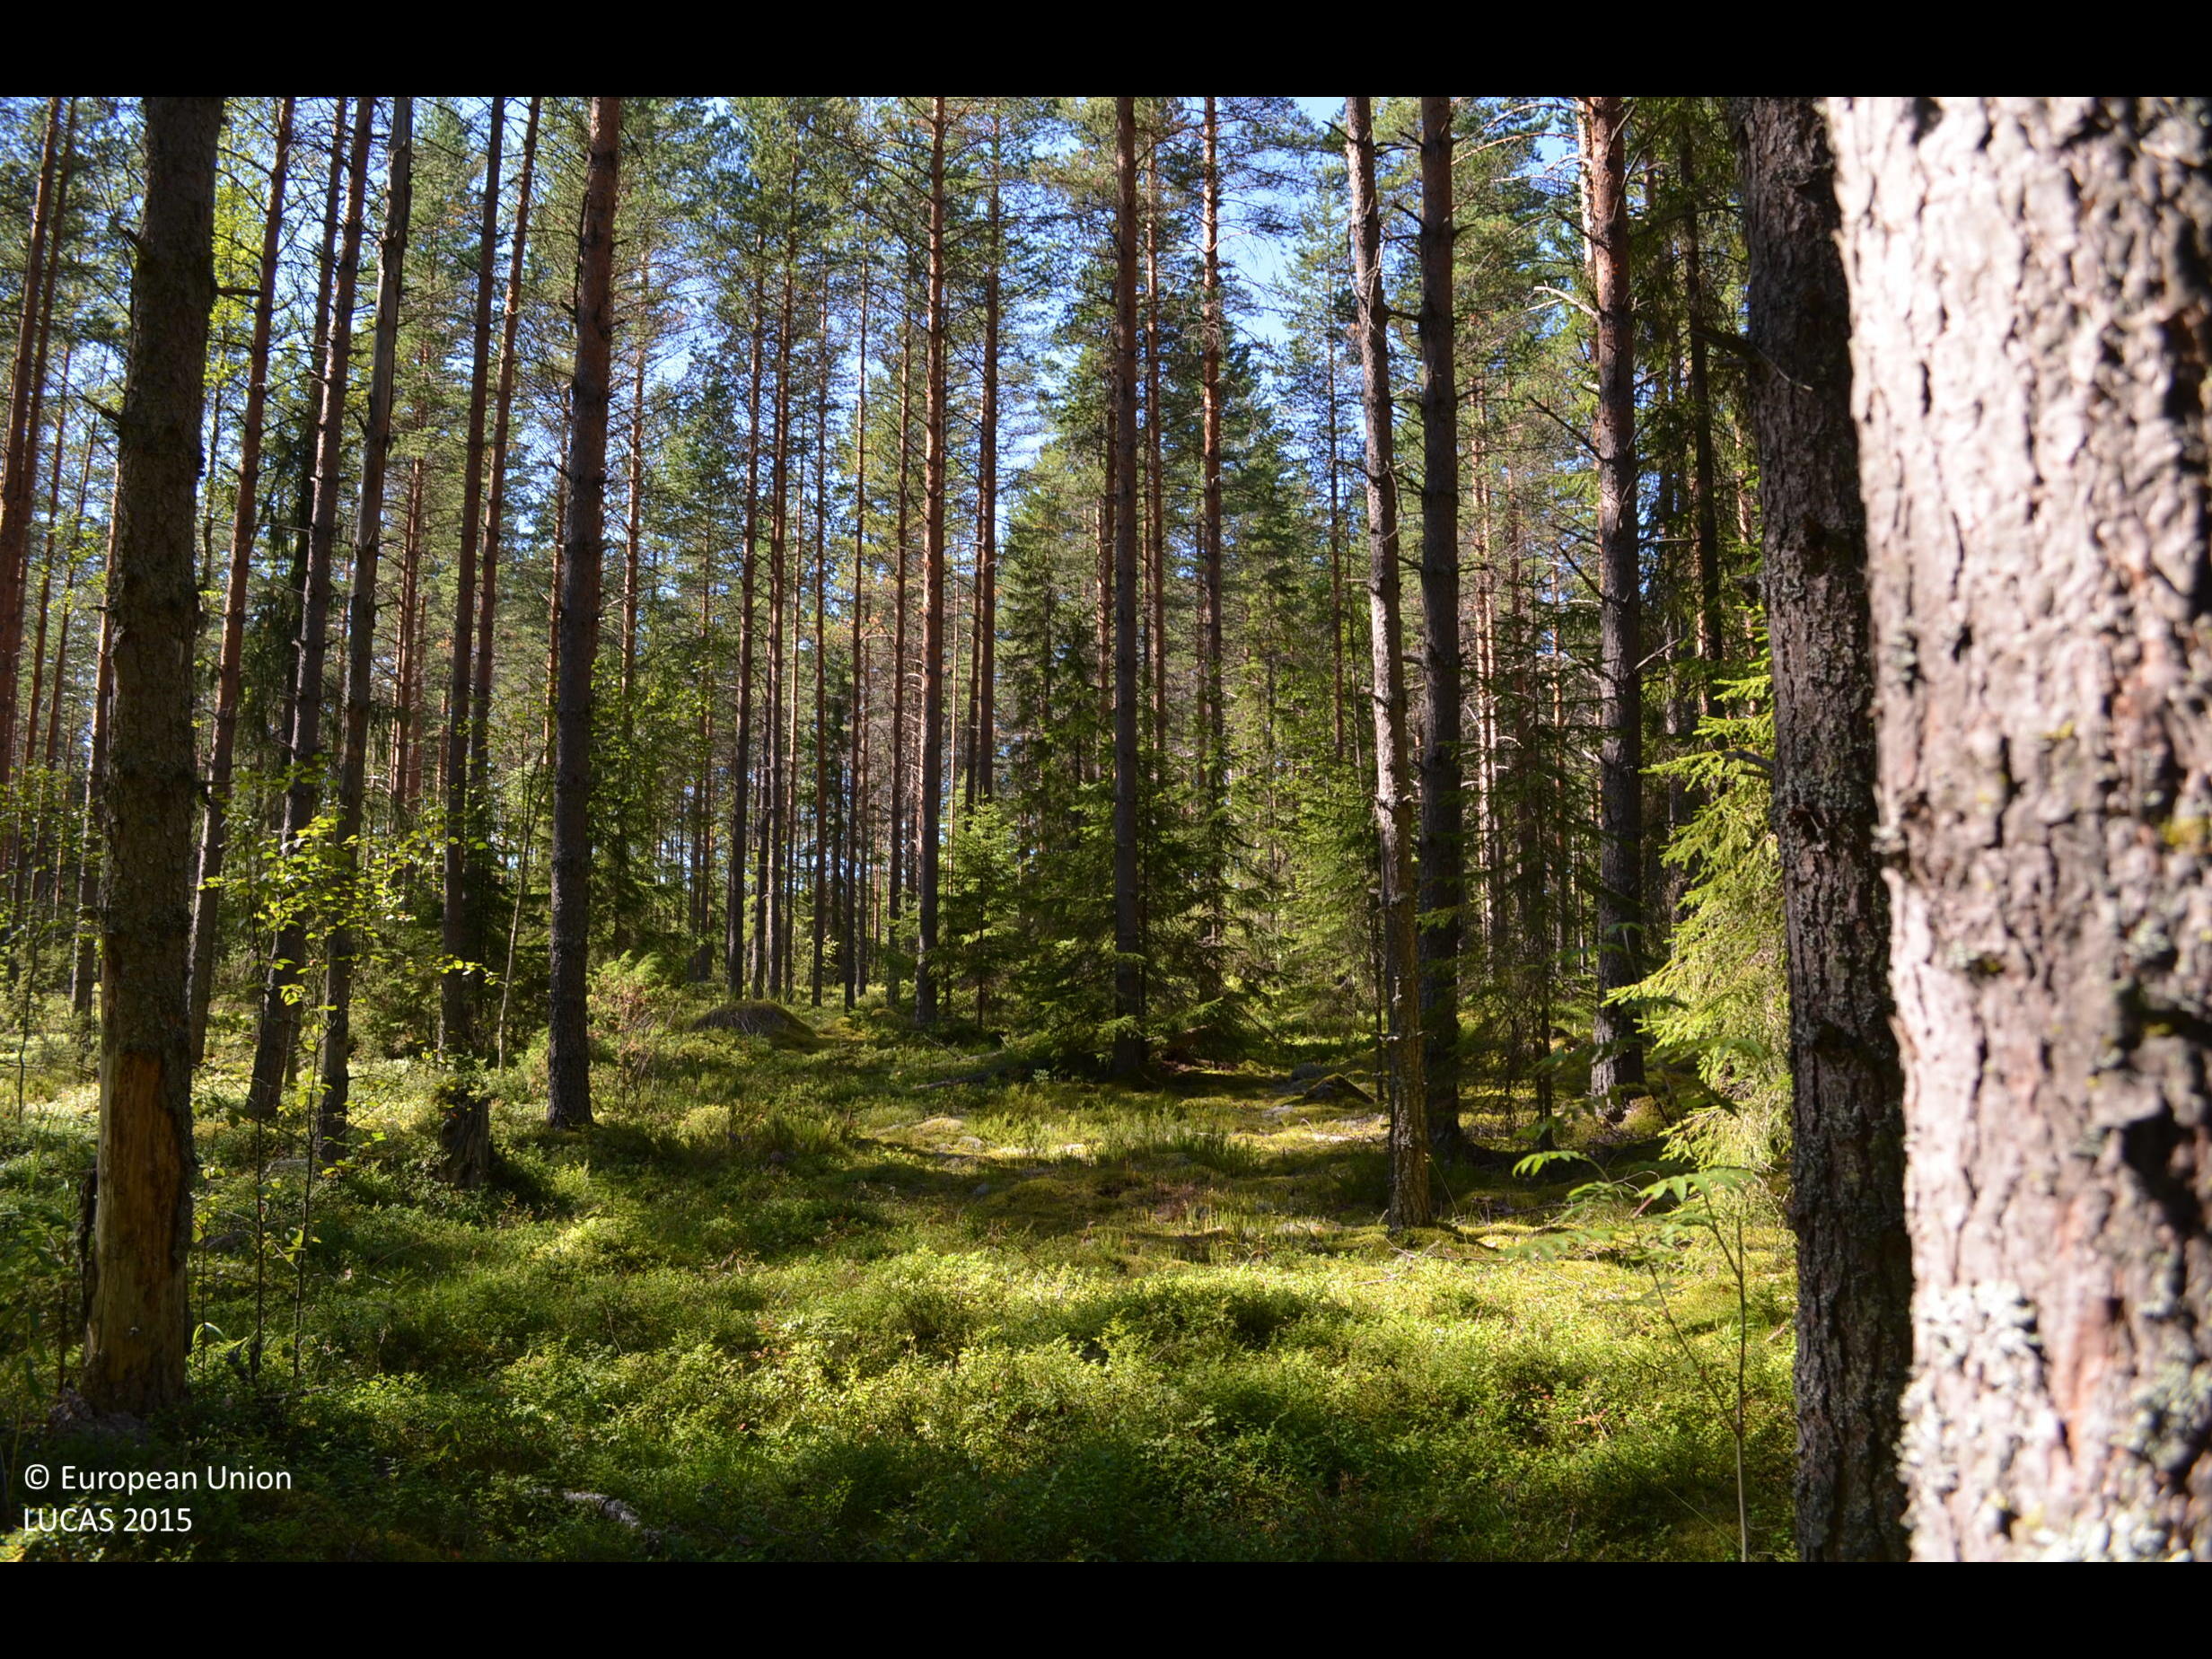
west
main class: Woodland
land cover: Other coniferous woodland
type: boreal forest
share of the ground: > 75 %
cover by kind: coniferous forest trees 70 %, shrubs 15 %, lichens and mosses 10 %, broadleaved forest trees 5 %
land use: Forestry
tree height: > 5 m
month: August
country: FI
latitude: 62.3808
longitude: 24.3378
